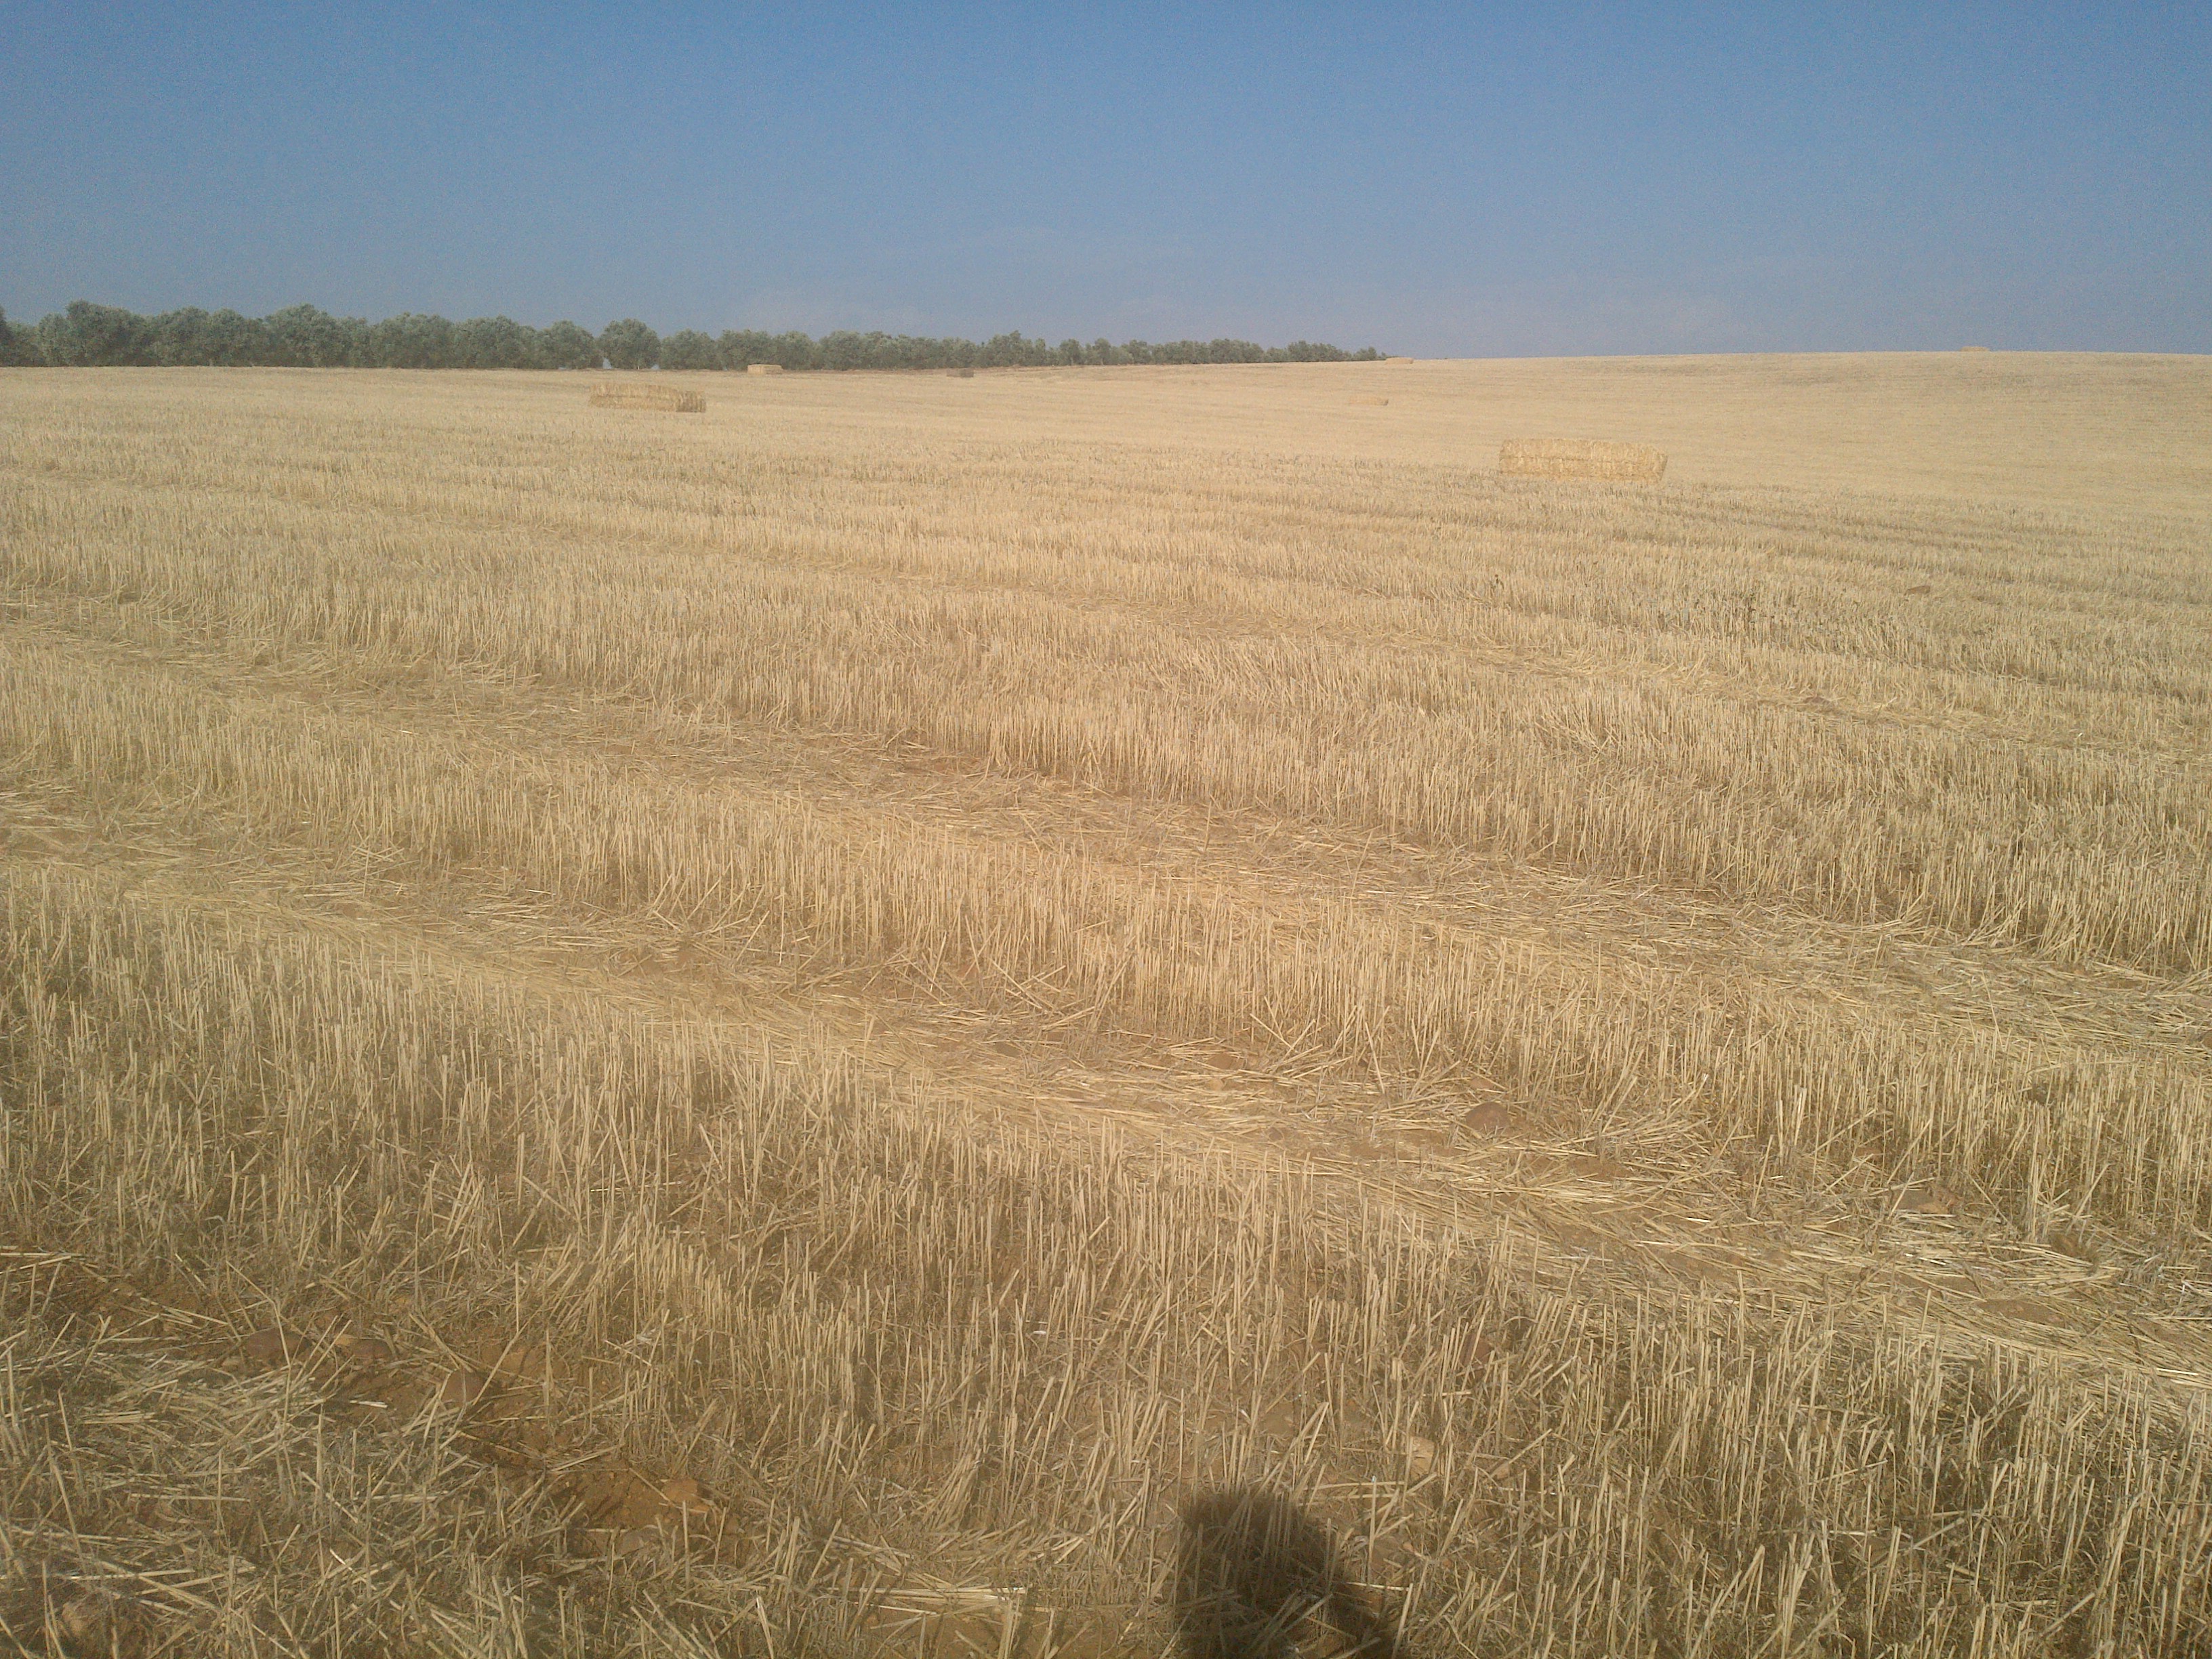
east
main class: Cropland
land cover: Durum wheat
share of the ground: < 10 %
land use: Agriculture (excluding fallow land and kitchen gardens)
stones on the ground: < 10 %
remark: Harvested field
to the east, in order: Durum wheat; Tracks; Olive groves
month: June
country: ES
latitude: 37.7454
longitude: -4.8918
